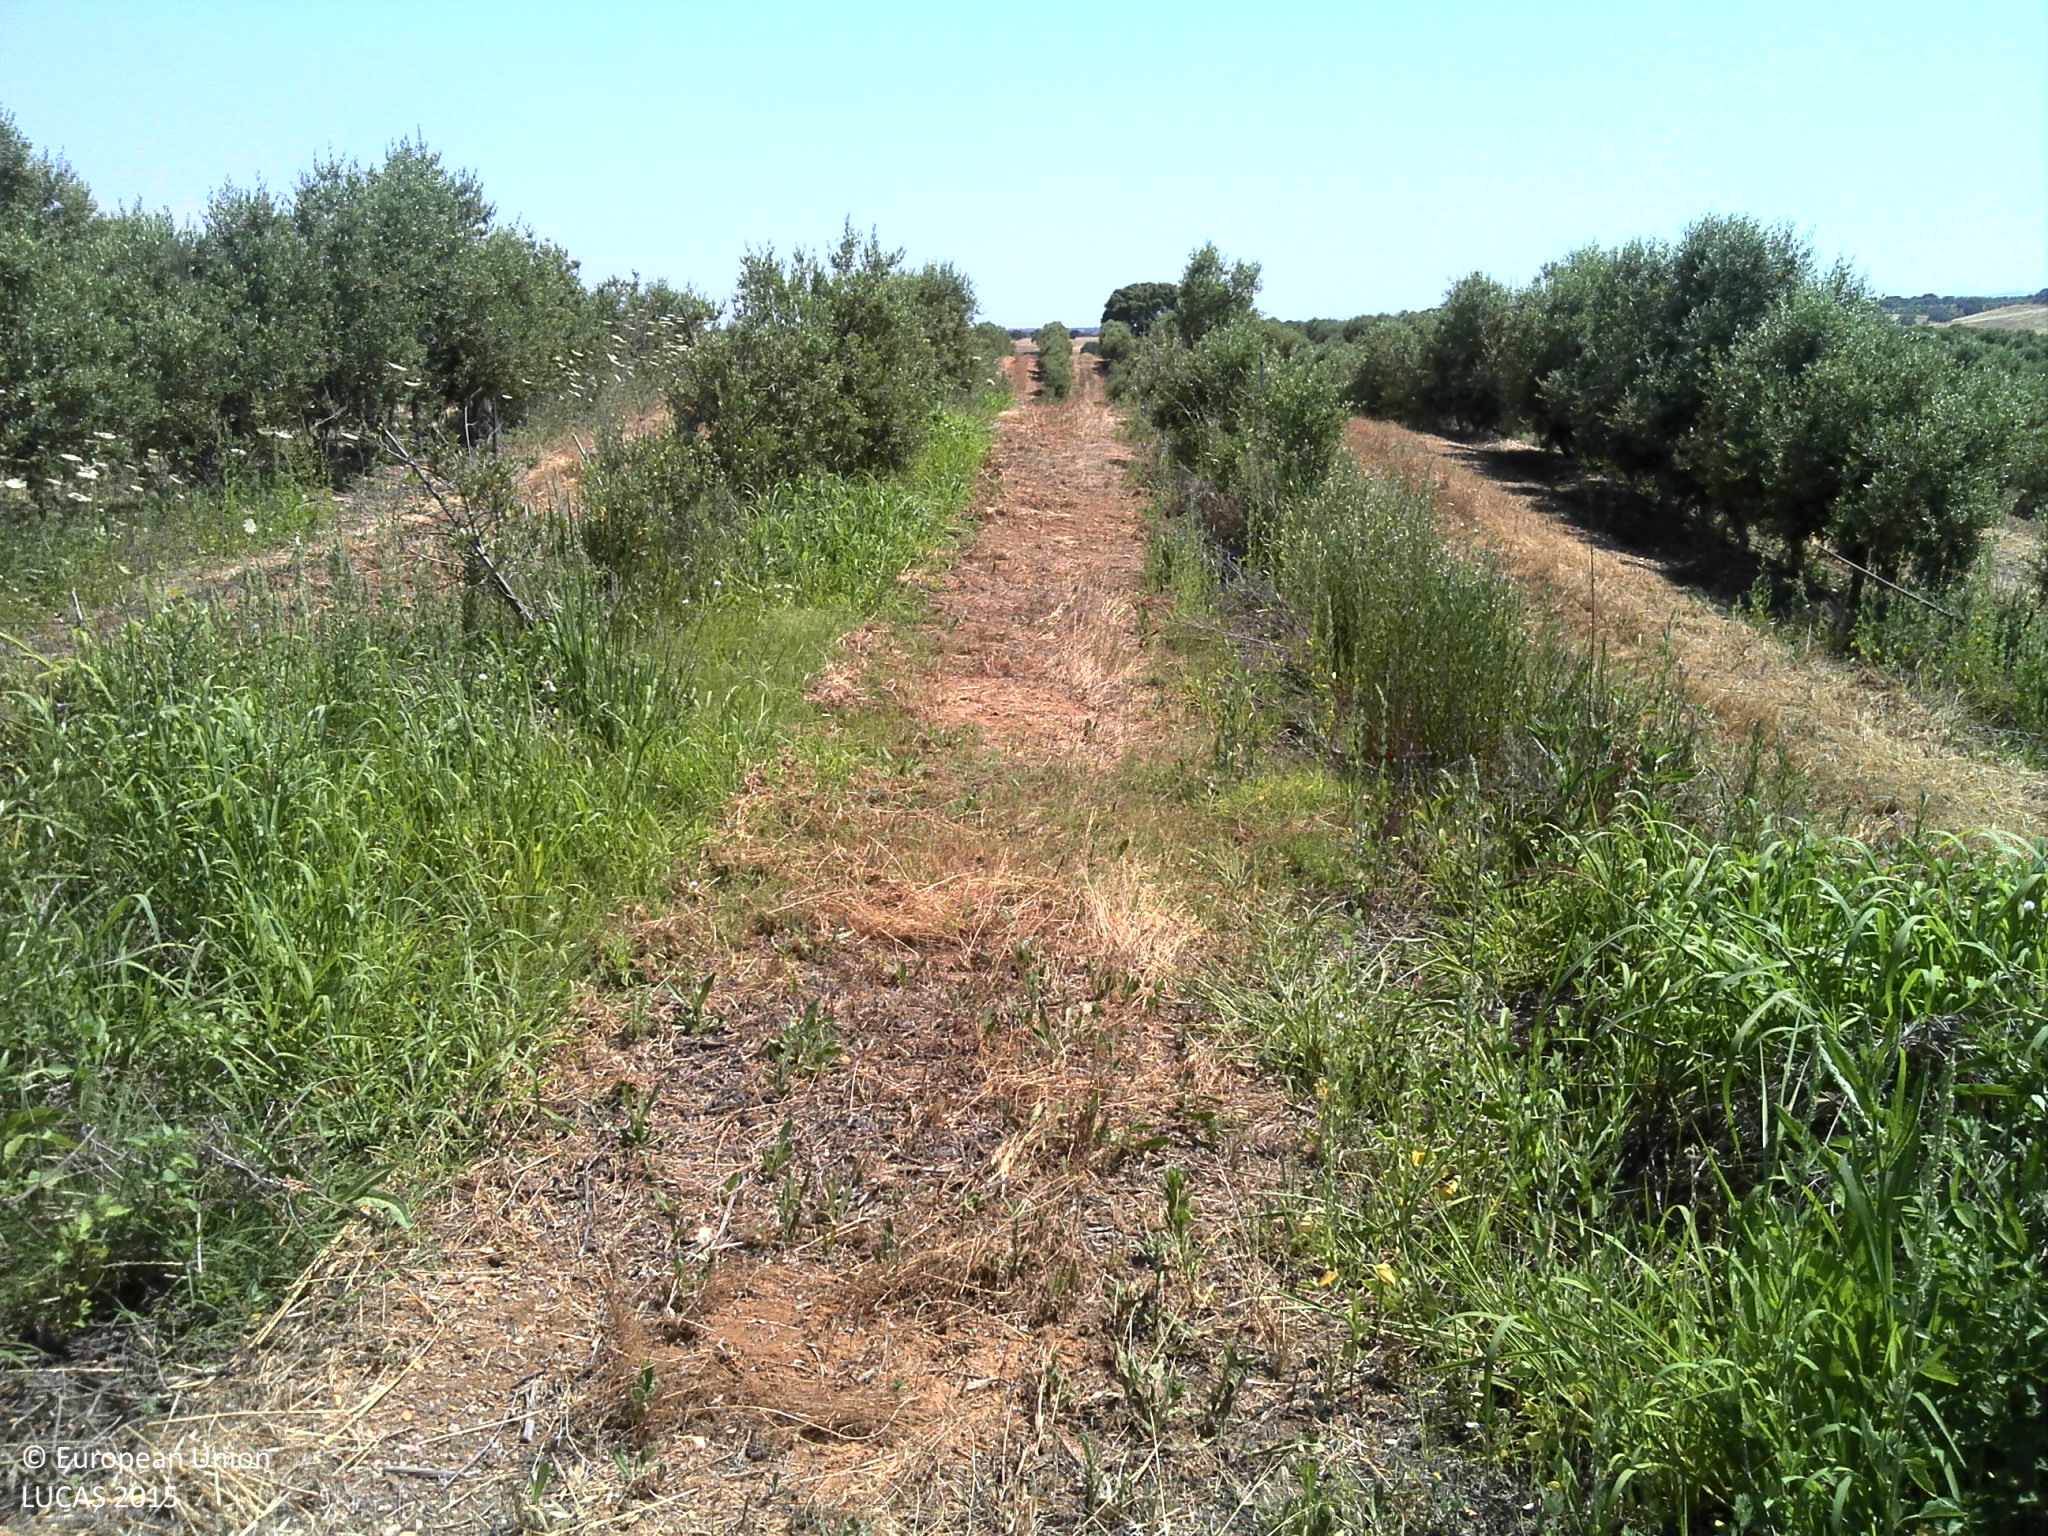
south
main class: Cropland
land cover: Olive groves
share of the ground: 25 - 50 %
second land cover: Spontaneously vegetated surfaces
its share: 10 - 25 %
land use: Agriculture (excluding fallow land and kitchen gardens)
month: June
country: PT
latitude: 37.8762
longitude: -8.3286
